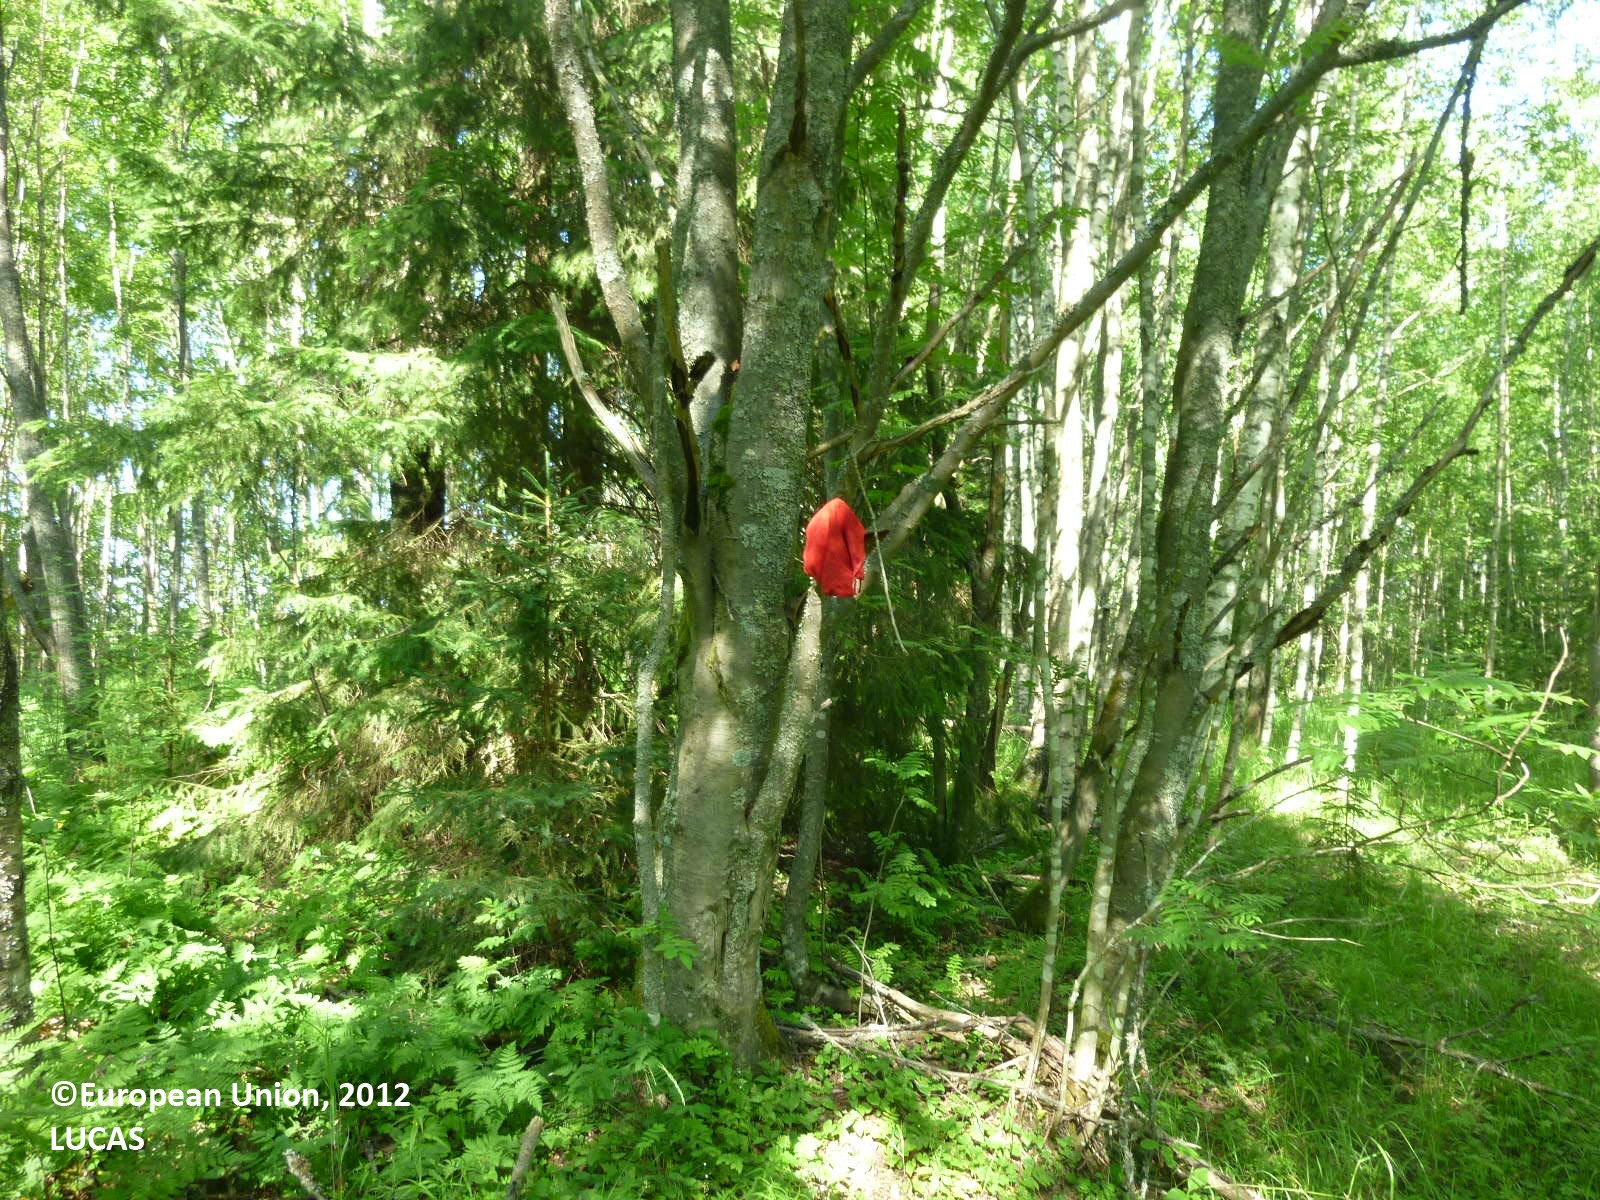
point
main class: Woodland
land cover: Broadleaved woodland
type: boreal forest
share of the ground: > 75 %
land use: Forestry
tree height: > 5 m
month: July
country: FI
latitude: 61.3479
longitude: 21.9662
